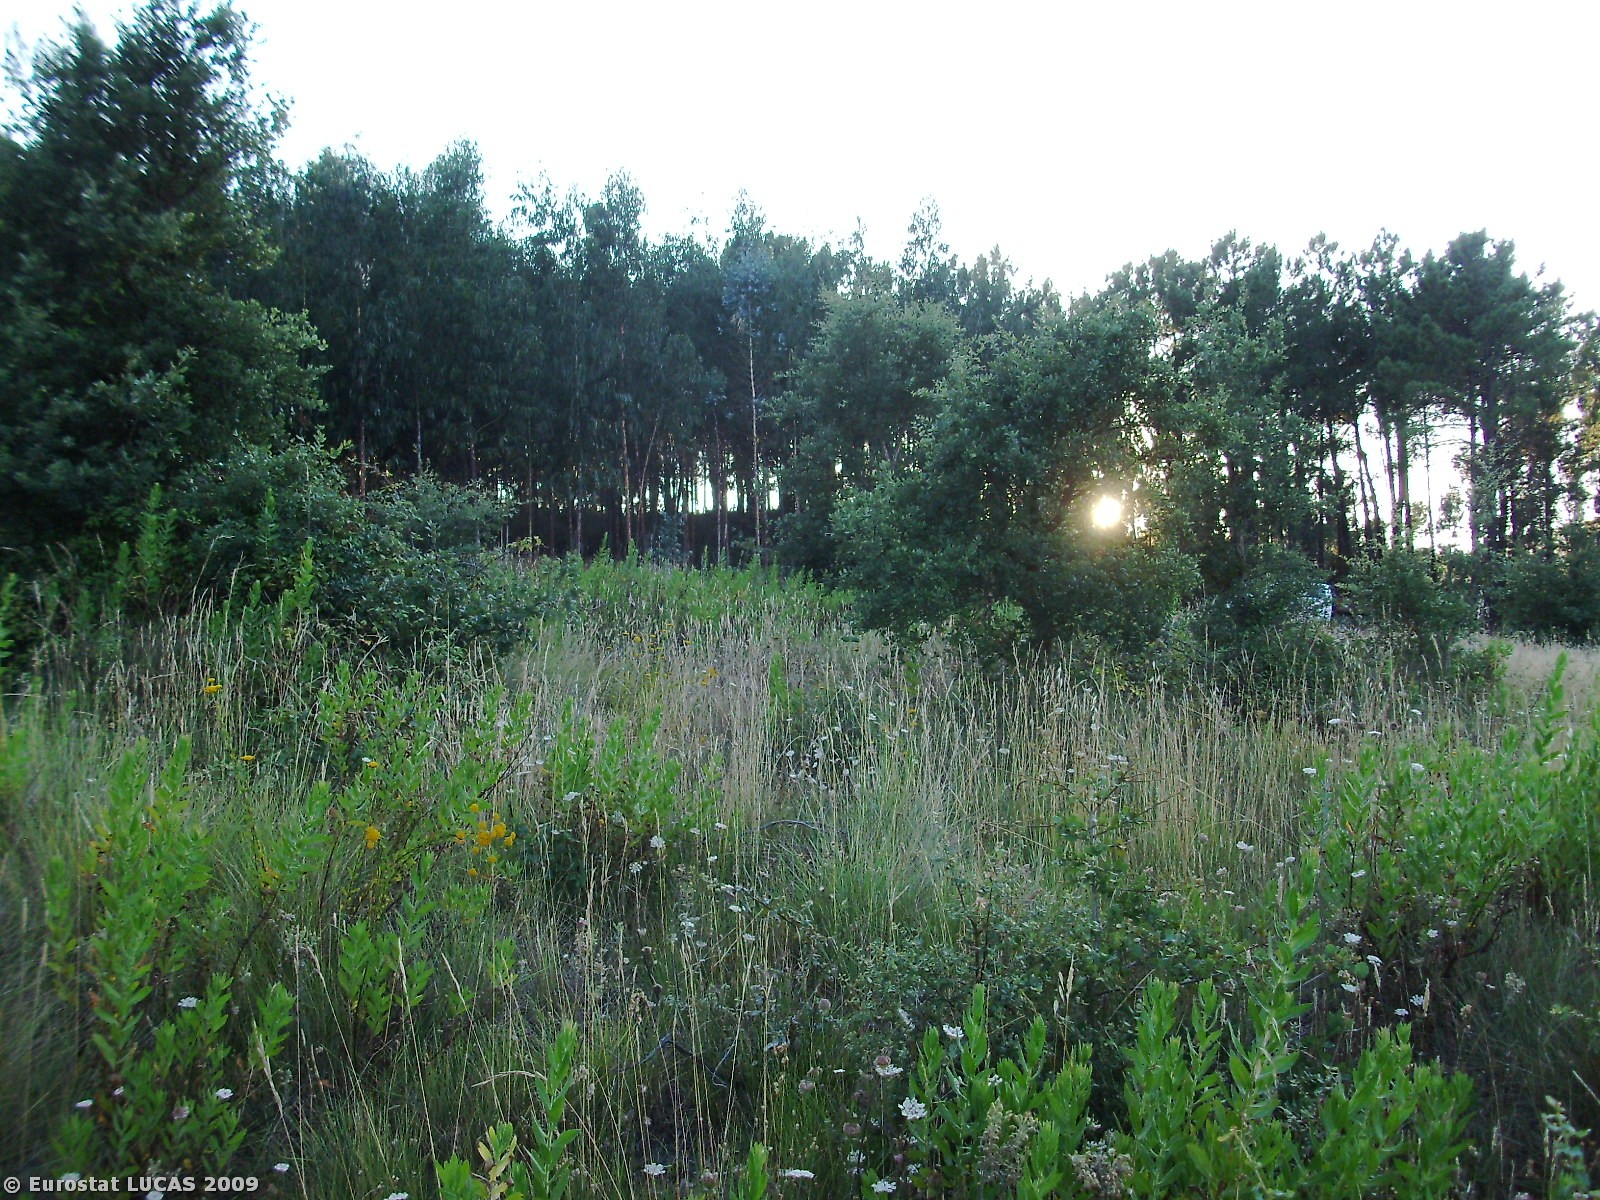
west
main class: Shrubland
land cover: Shrubland with sparse tree cover
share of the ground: > 75 %
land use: Fallow land
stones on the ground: 10 - 25 %
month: July
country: PT
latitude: 39.4098
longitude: -8.9086
